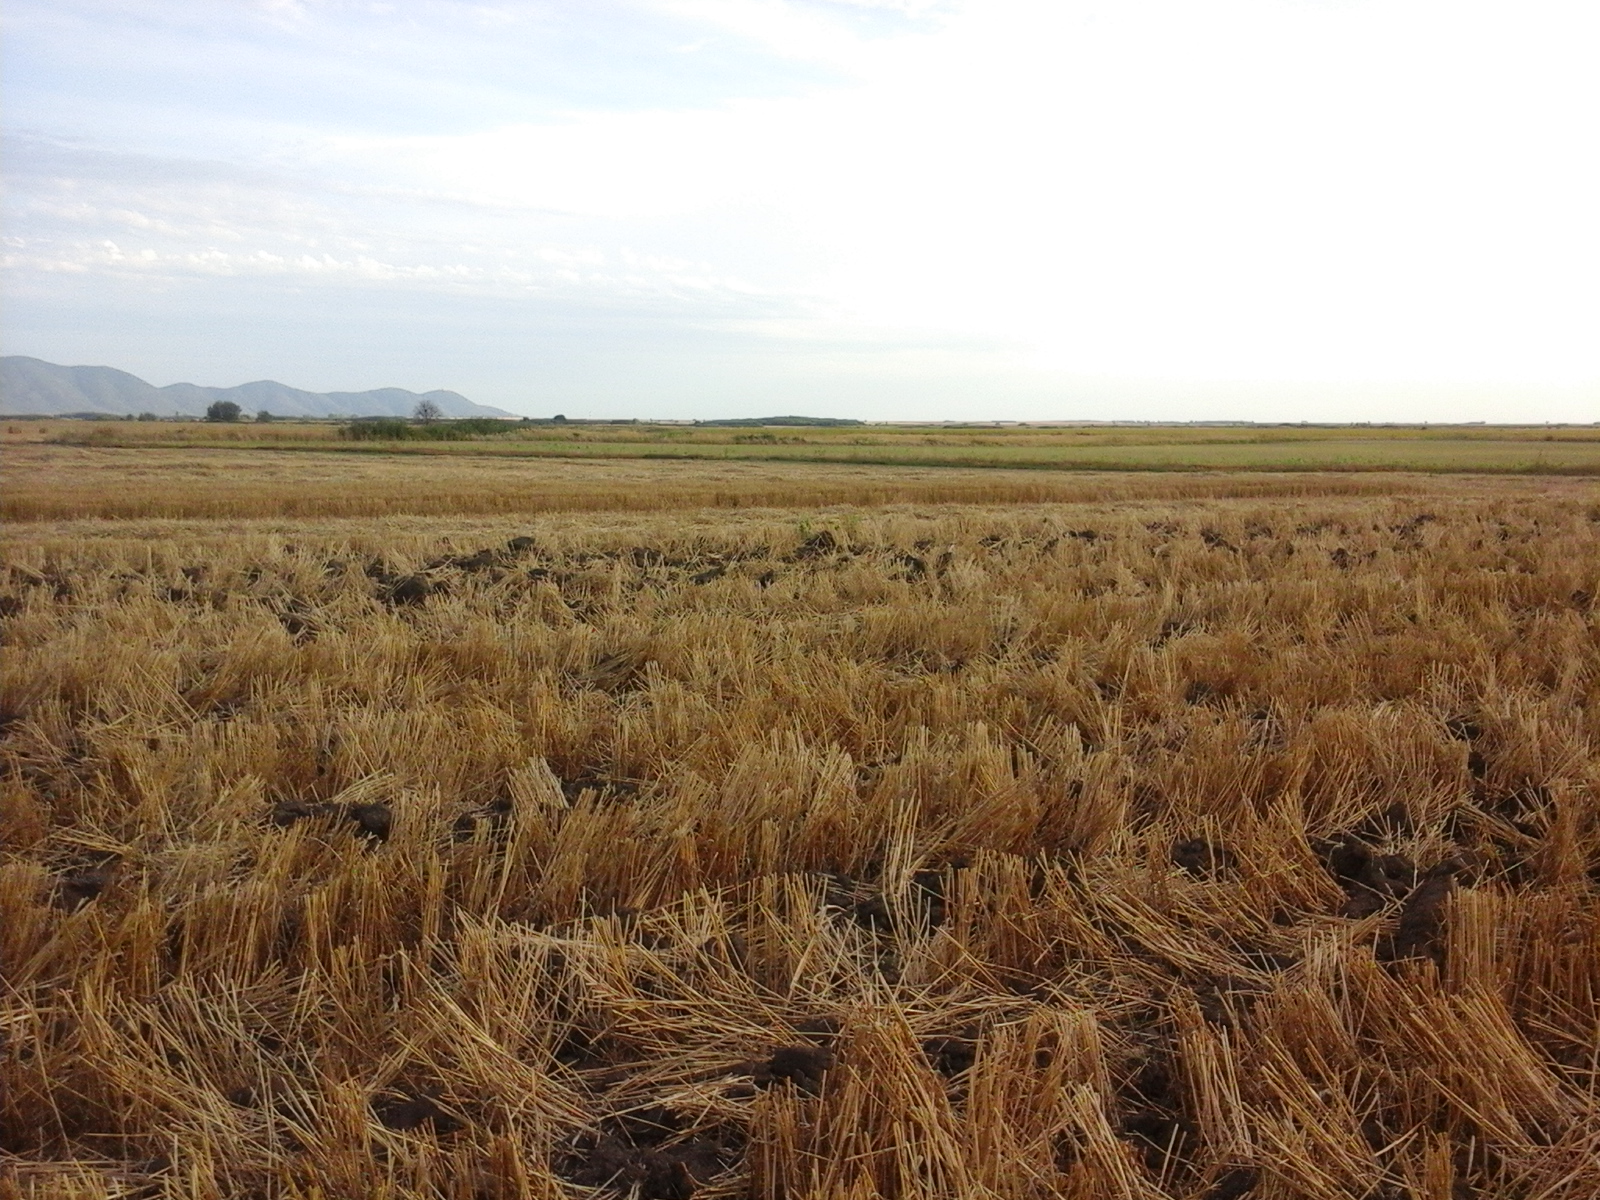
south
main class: Cropland
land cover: Common wheat
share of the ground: 25 - 50 %
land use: Agriculture (excluding fallow land and kitchen gardens)
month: August
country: RO
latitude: 45.2560
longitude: 21.3316
